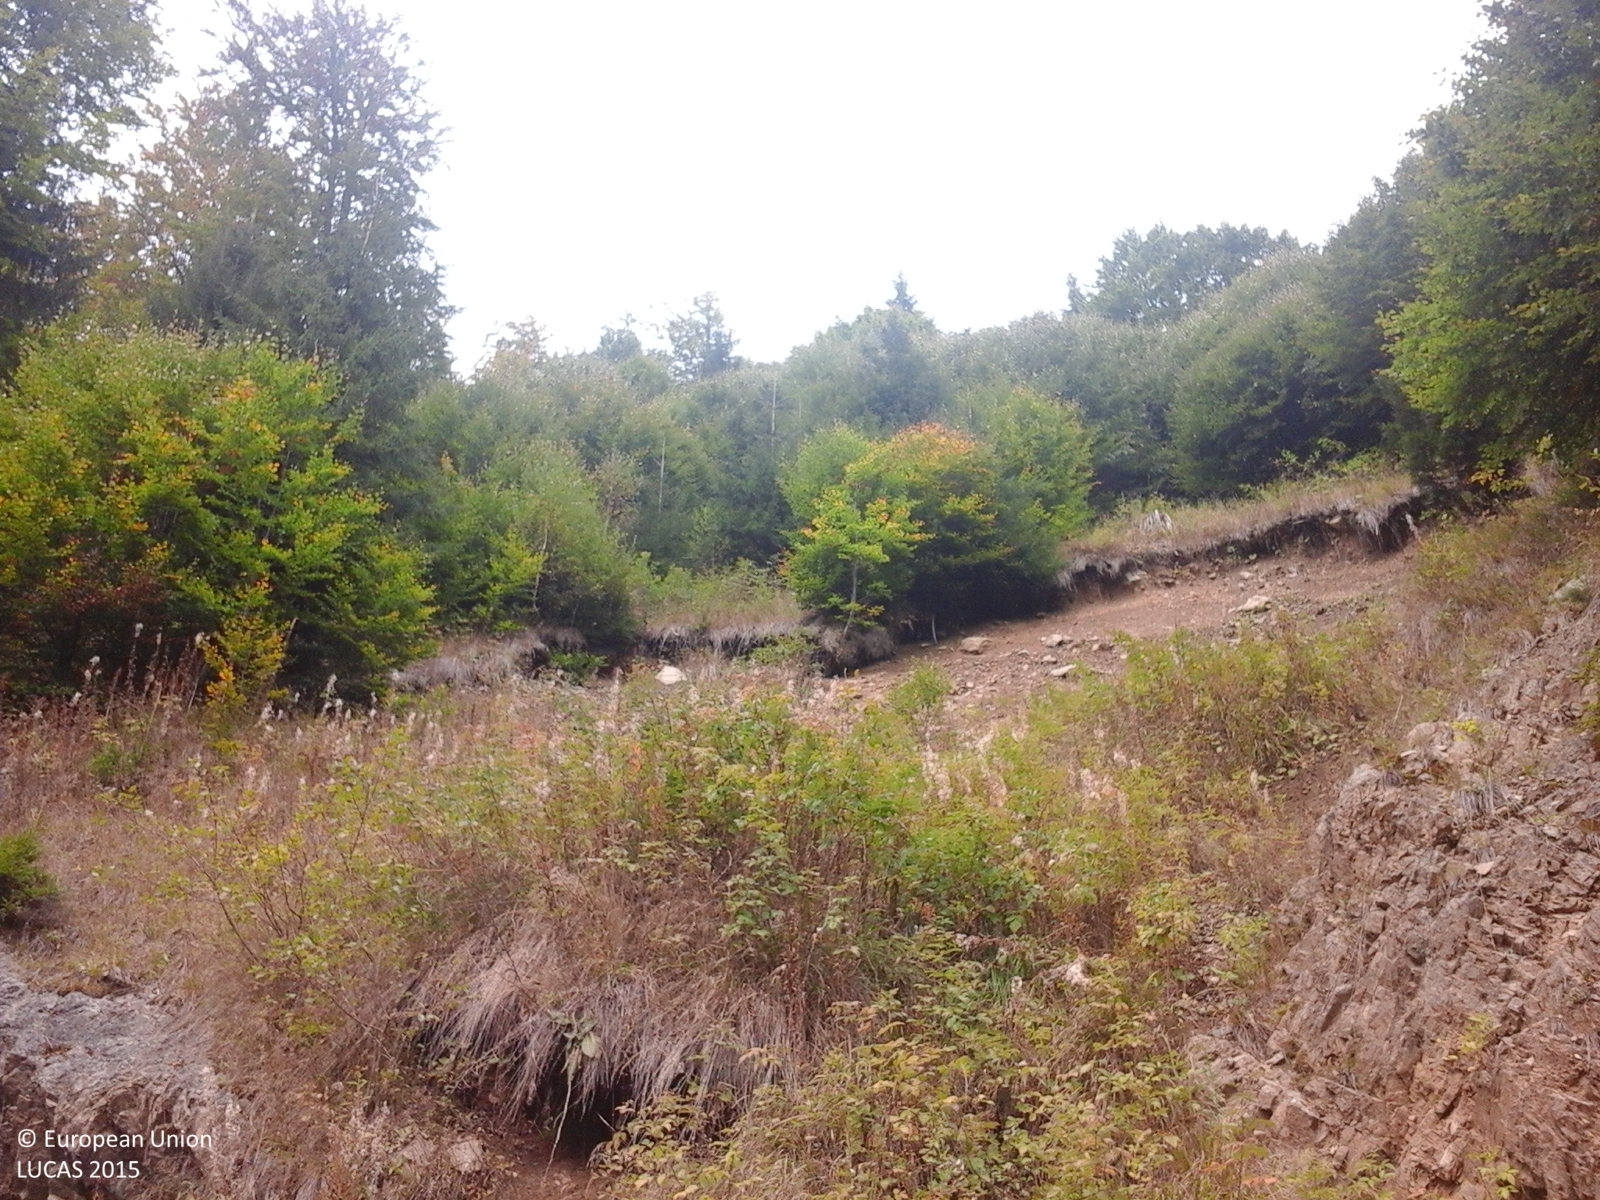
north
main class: Woodland
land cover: Spruce dominated mixed woodland
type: alpine coniferous forest
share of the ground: > 75 %
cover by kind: coniferous forest trees 65 %, broadleaved forest trees 35 %
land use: Forestry
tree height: > 5 m
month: September
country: RO
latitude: 45.4123
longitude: 23.5417
